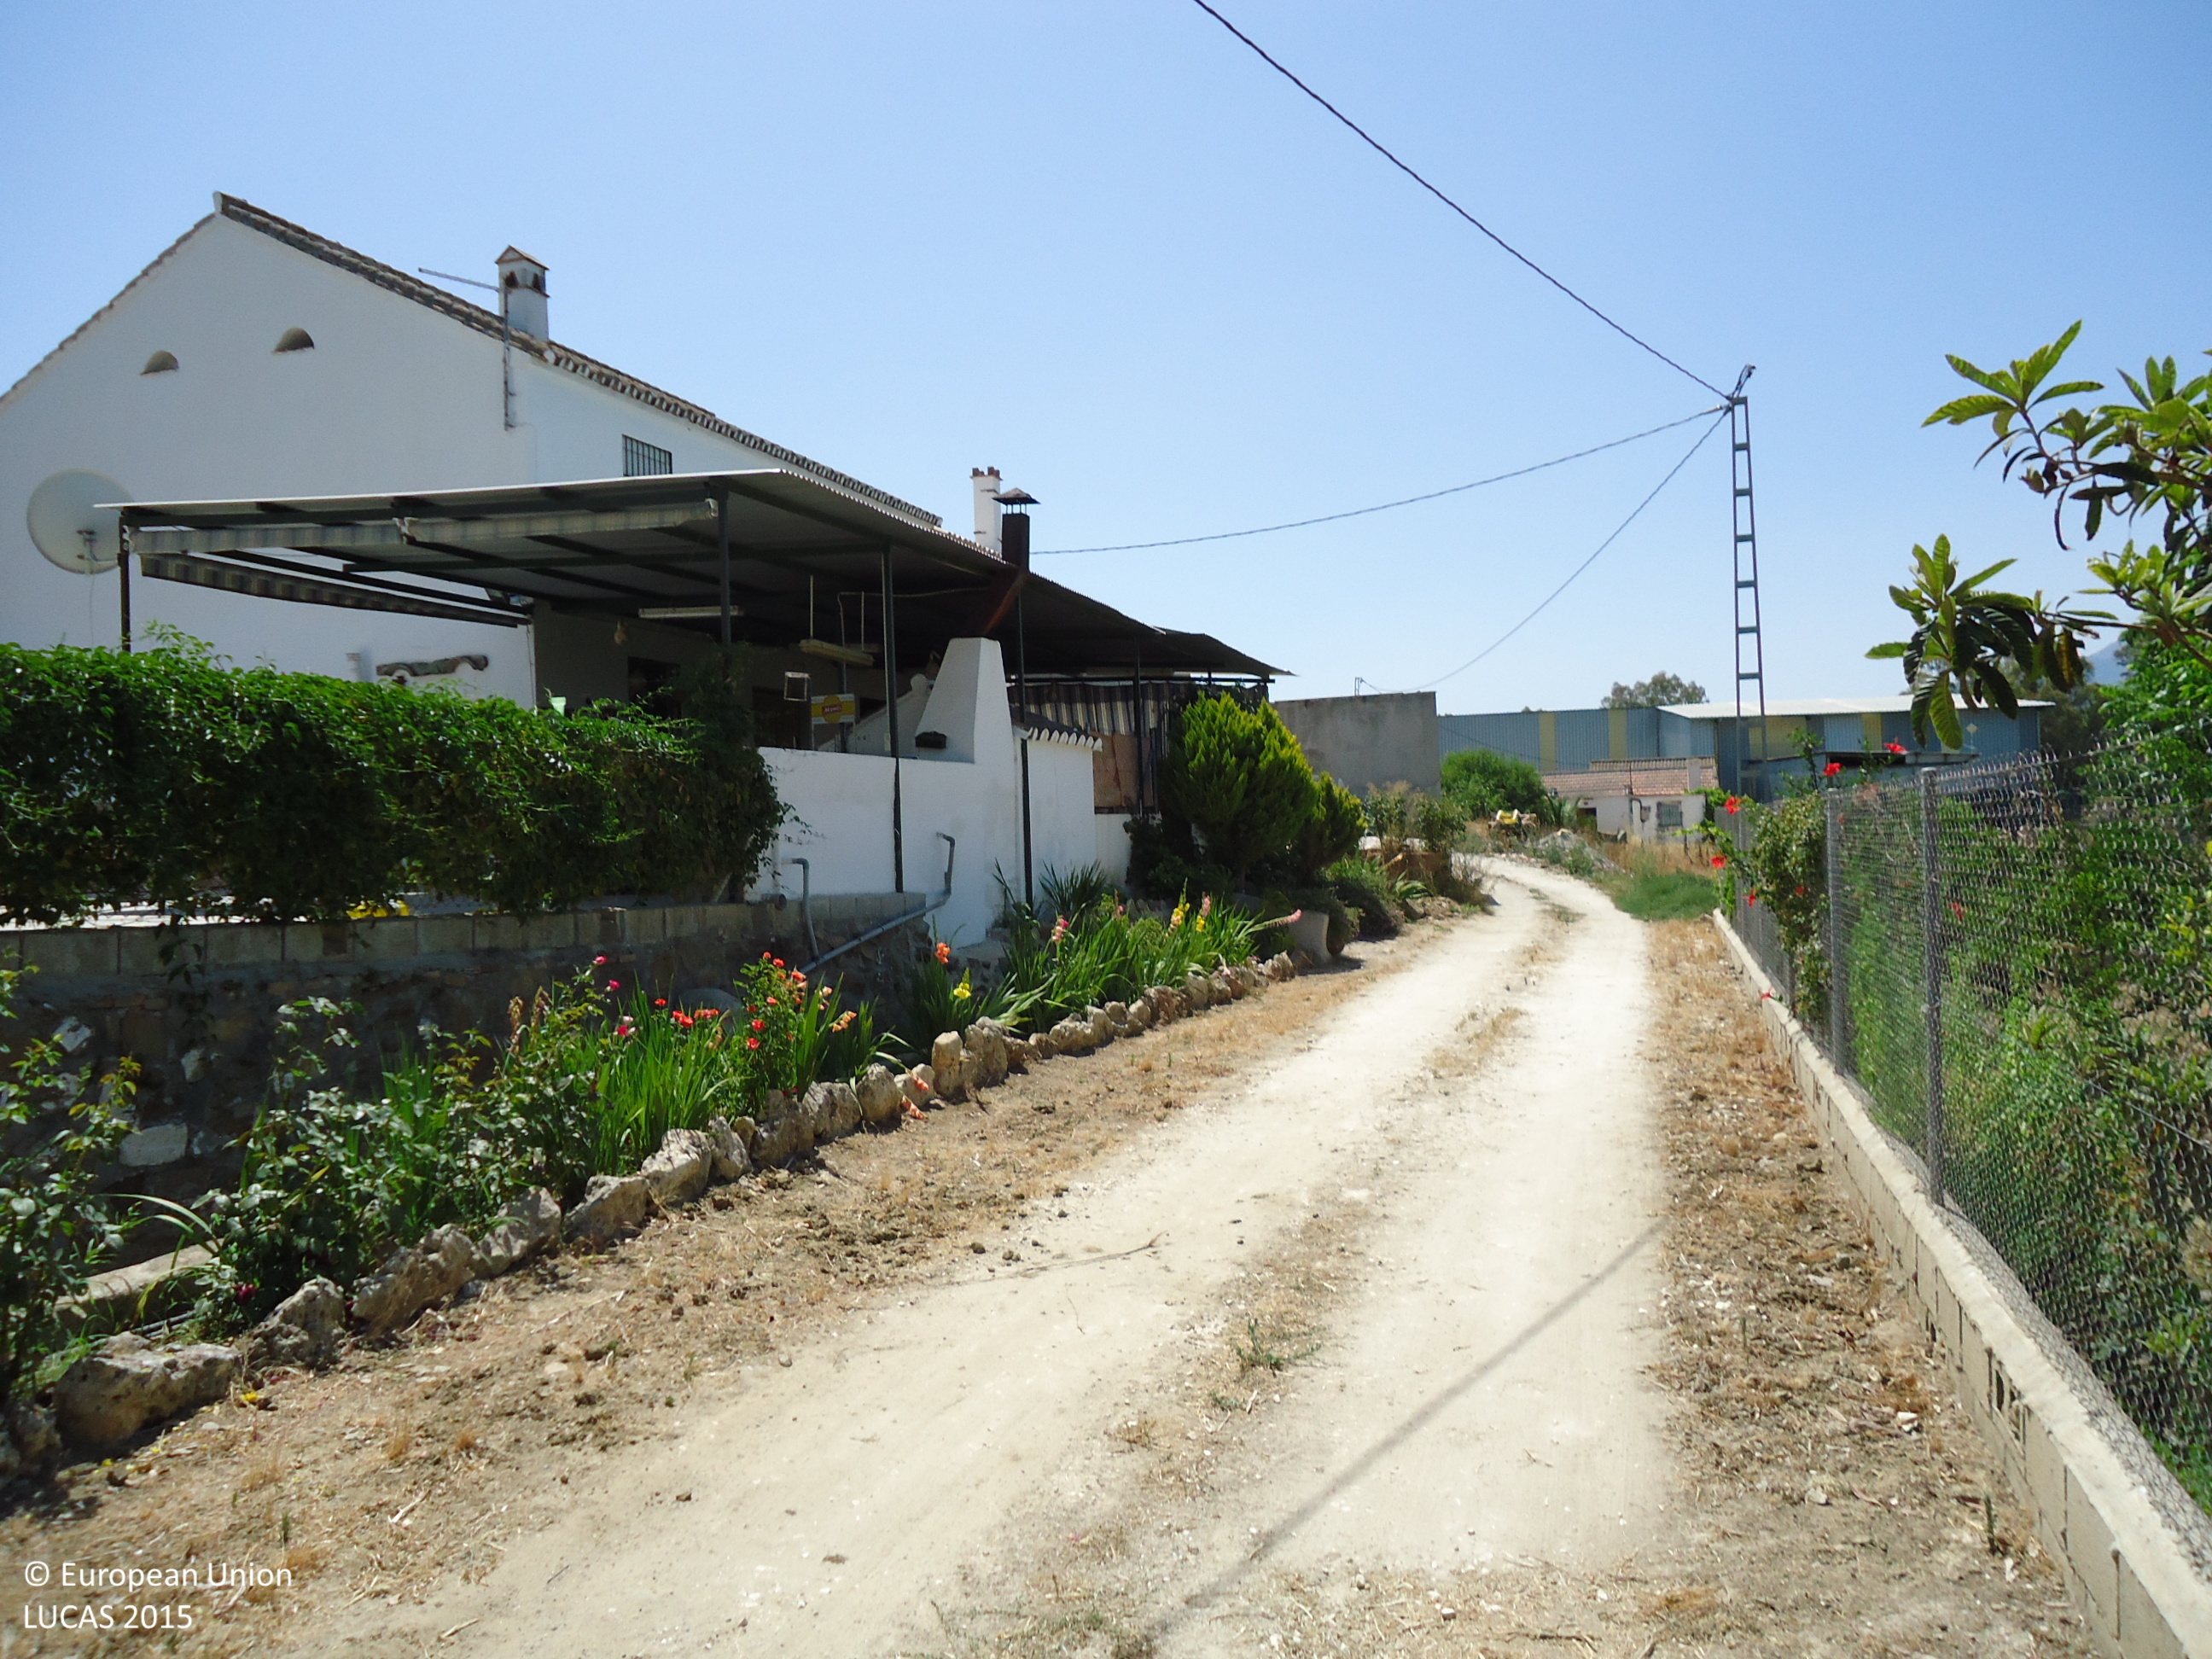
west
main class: Cropland
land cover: Oranges
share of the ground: 25 - 50 %
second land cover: Spontaneously vegetated surfaces
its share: > 75 %
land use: Agriculture (excluding fallow land and kitchen gardens)
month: June
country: ES
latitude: 36.6998
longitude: -4.7571
